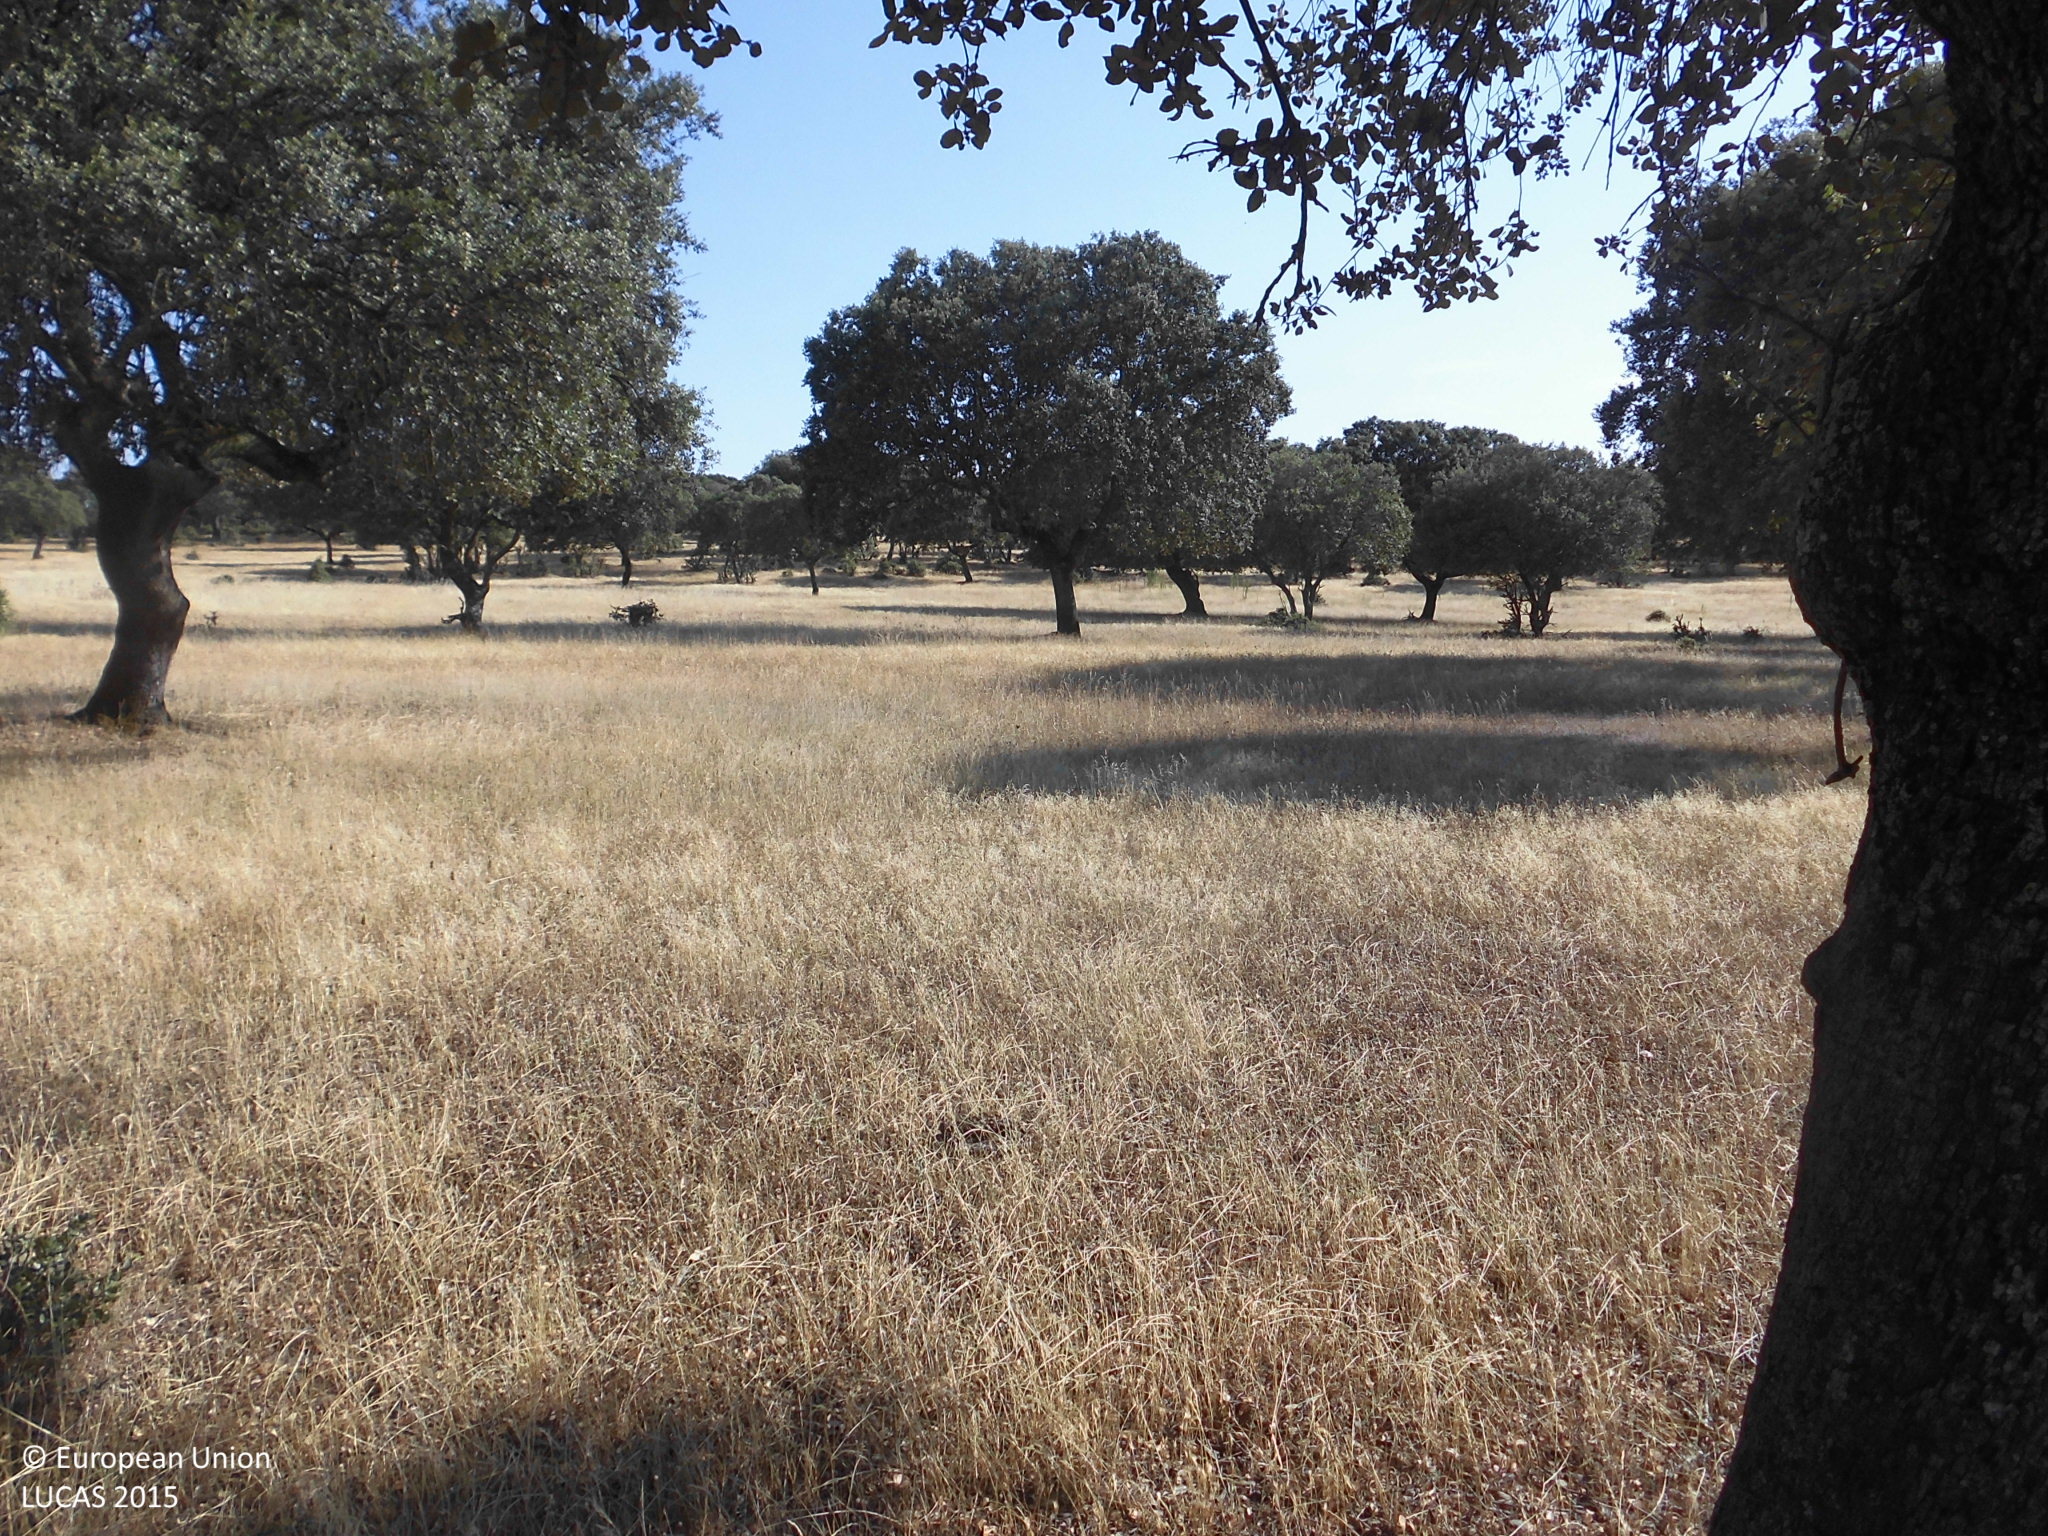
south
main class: Woodland
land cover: Broadleaved woodland
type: broadleaved evergreen forest
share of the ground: 25 - 50 %
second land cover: Grassland without tree/shrub cover
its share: > 75 %
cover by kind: broadleaved forest trees 50 %, herbaceous plants 50 %
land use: Forestry
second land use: Agriculture (excluding fallow land and kitchen gardens)
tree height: > 5 m
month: June
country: ES
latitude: 39.9376
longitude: -6.1148
